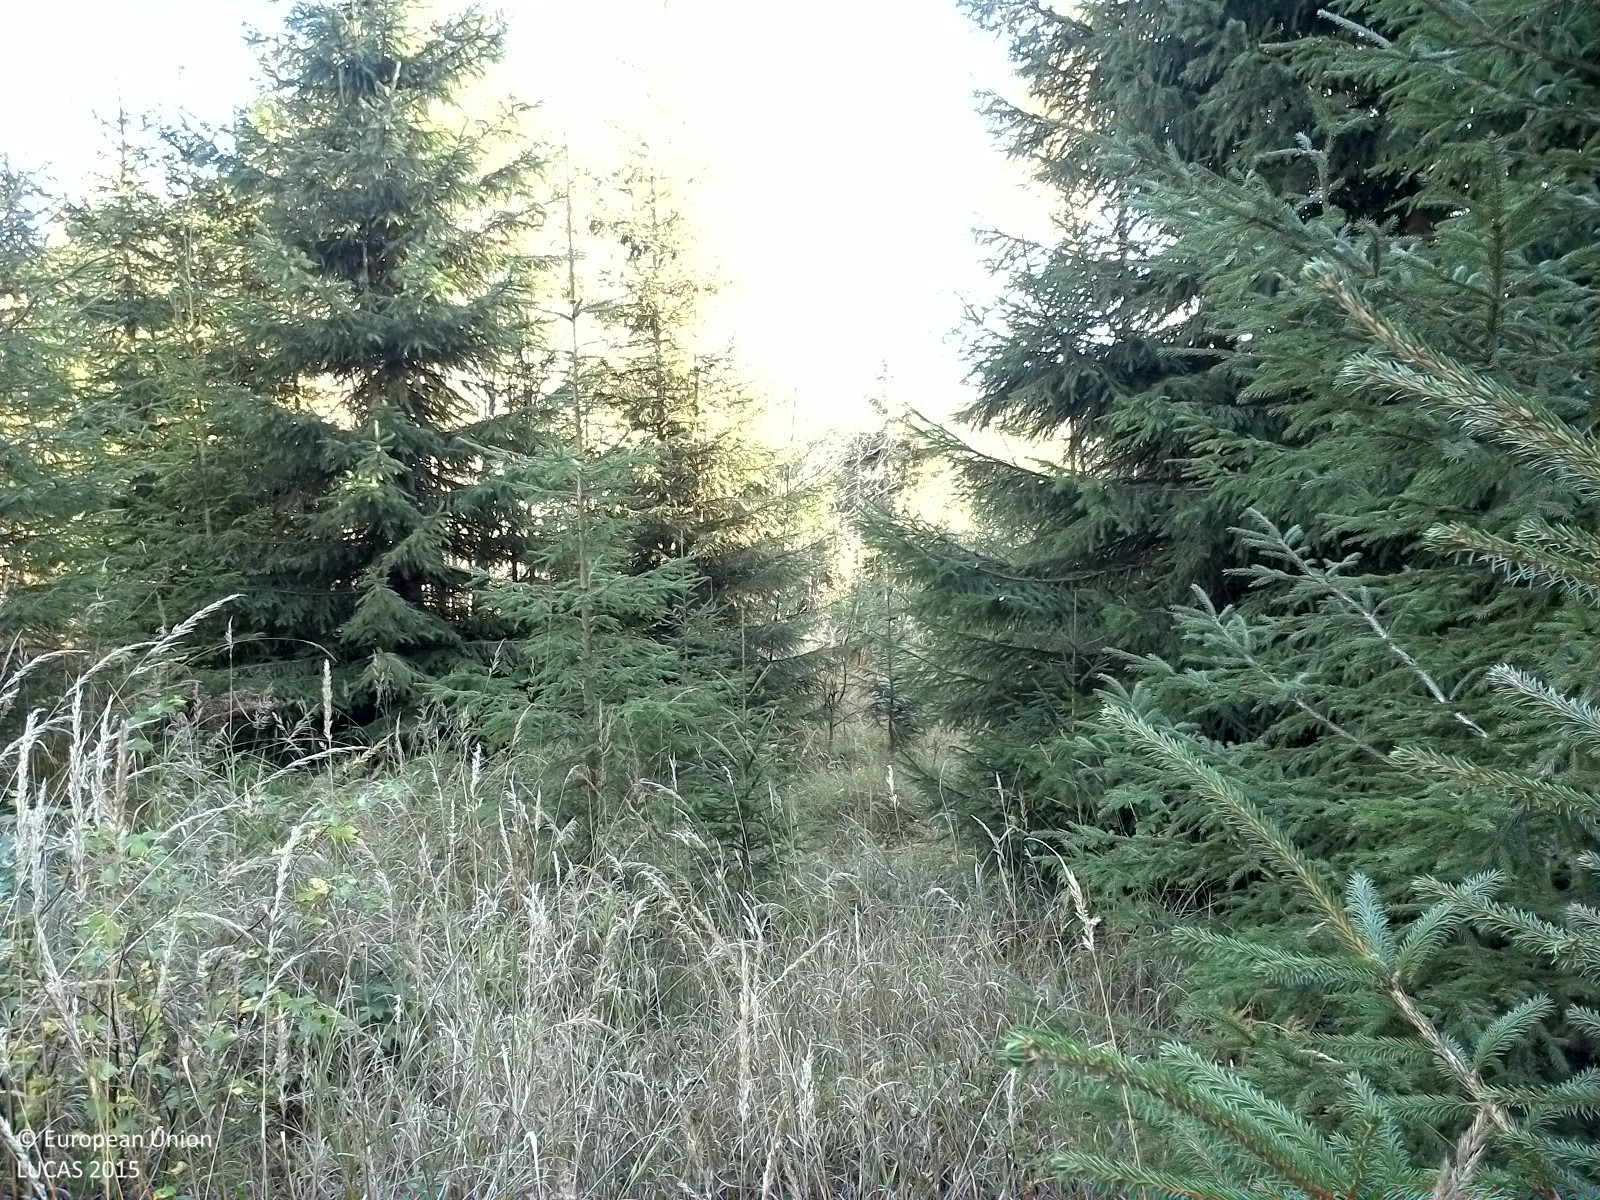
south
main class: Woodland
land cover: Spruce dominated coniferous woodland
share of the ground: 25 - 50 %
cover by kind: herbaceous plants 70 %, coniferous forest trees 25 %, broadleaved forest trees 5 %
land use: Forestry
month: September
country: SE
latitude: 62.6531
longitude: 16.9055
